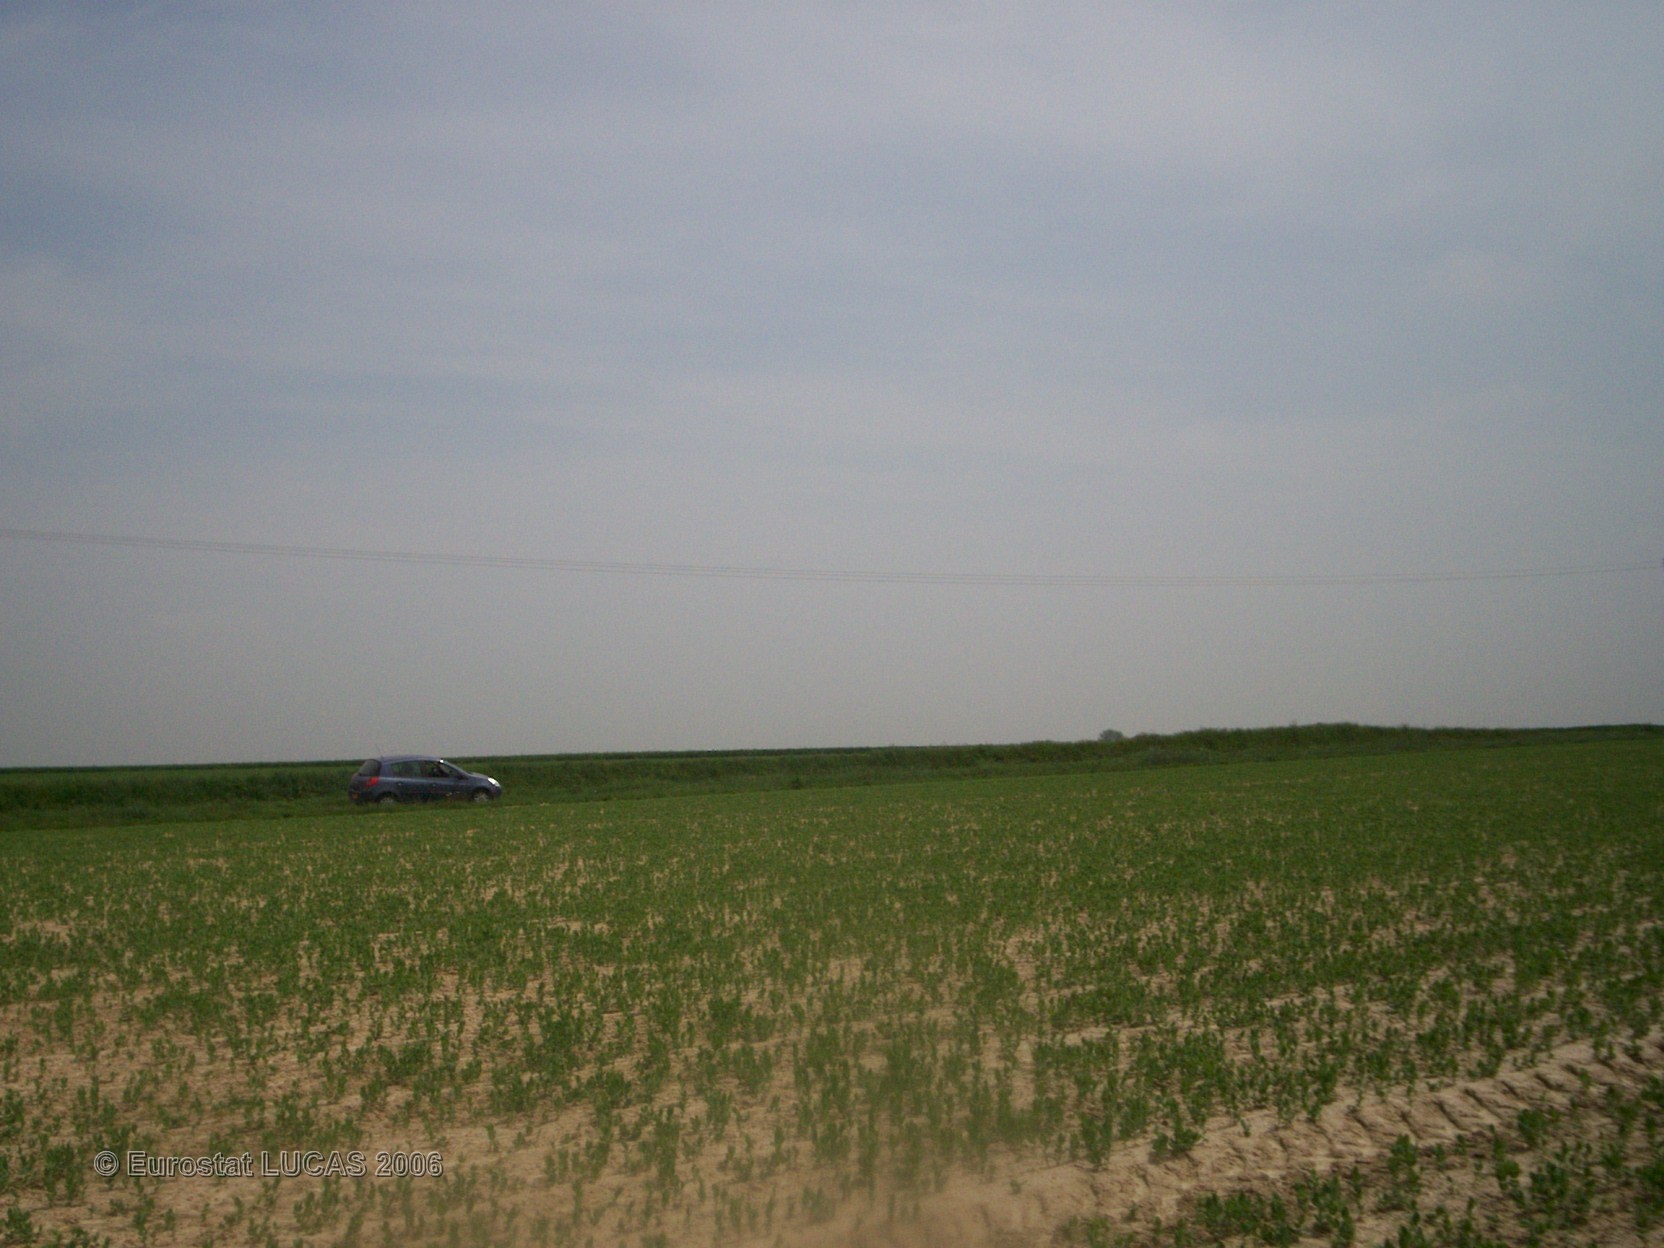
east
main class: Cropland
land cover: Dry pulses
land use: Agriculture (excluding fallow land and kitchen gardens)
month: May
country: FR
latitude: 47.9086
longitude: 2.9690
